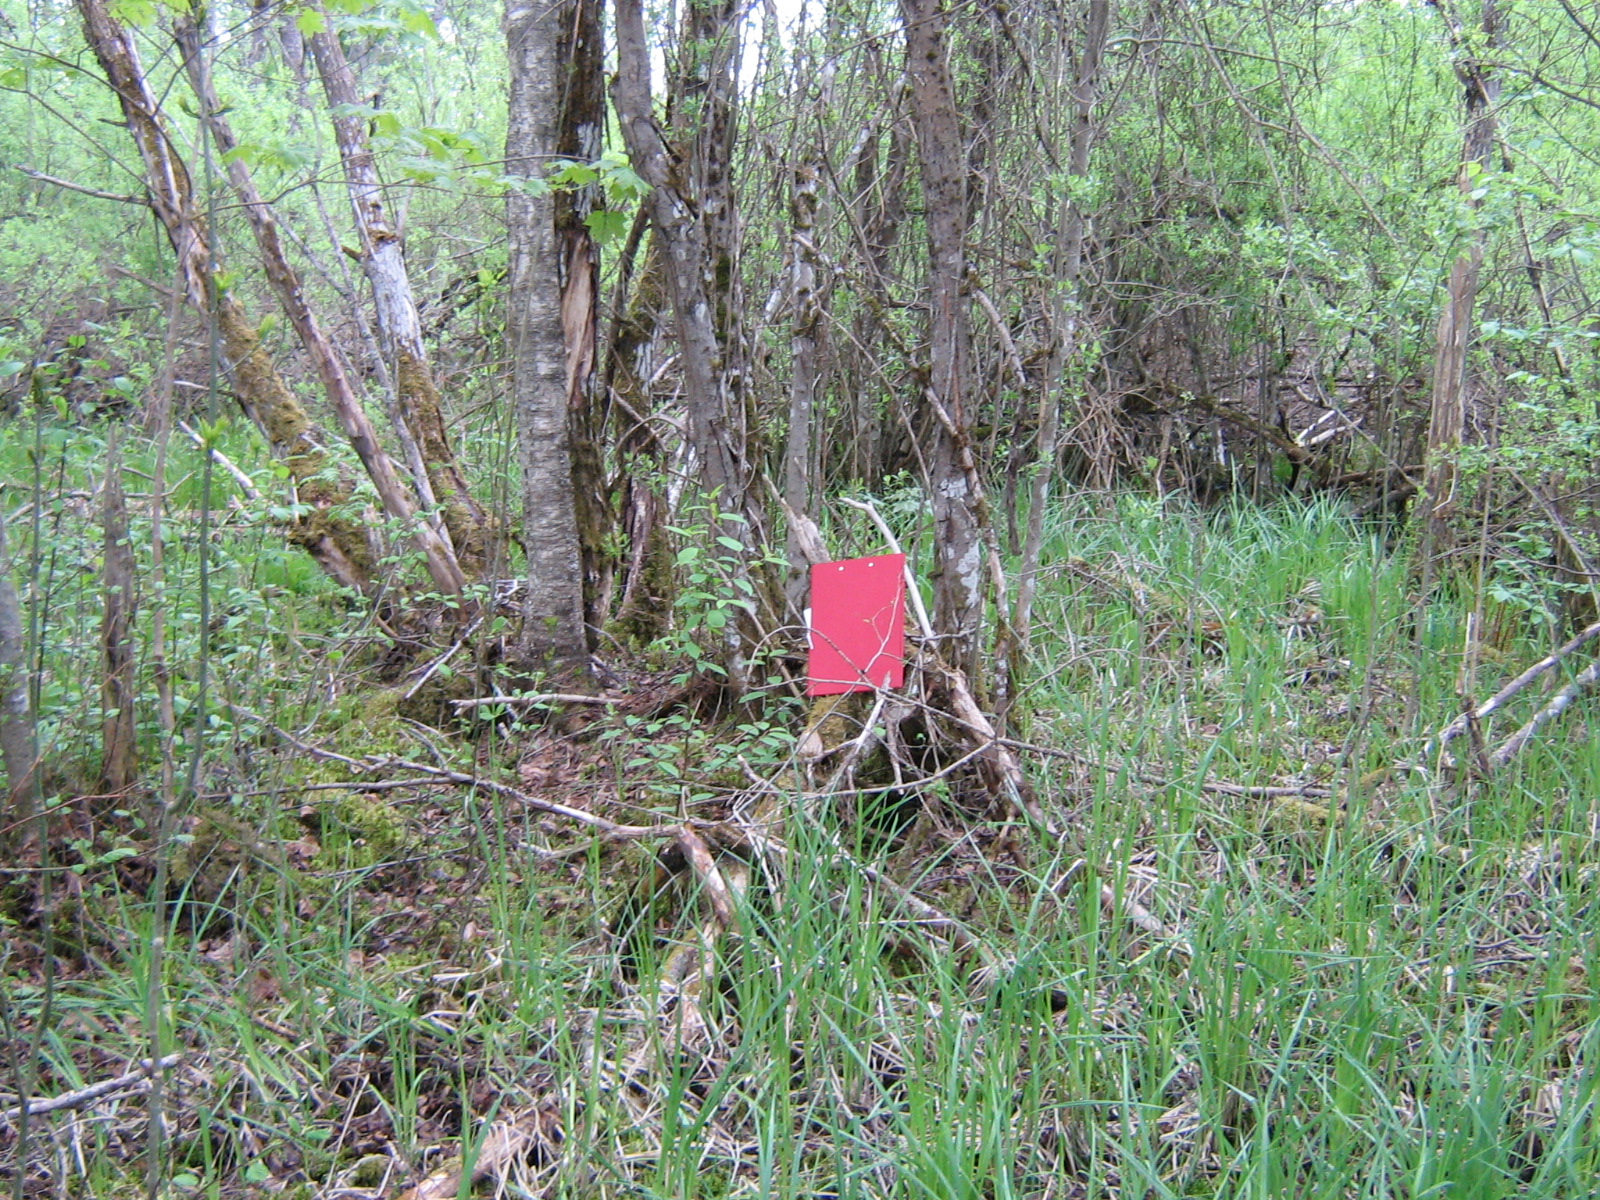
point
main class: Woodland
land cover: Broadleaved woodland
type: floodplain forest
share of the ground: > 75 %
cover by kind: broadleaved forest trees 100 %
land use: Semi-natural and natural areas not in use
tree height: > 5 m
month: May
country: LV
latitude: 57.0917
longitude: 25.6508
